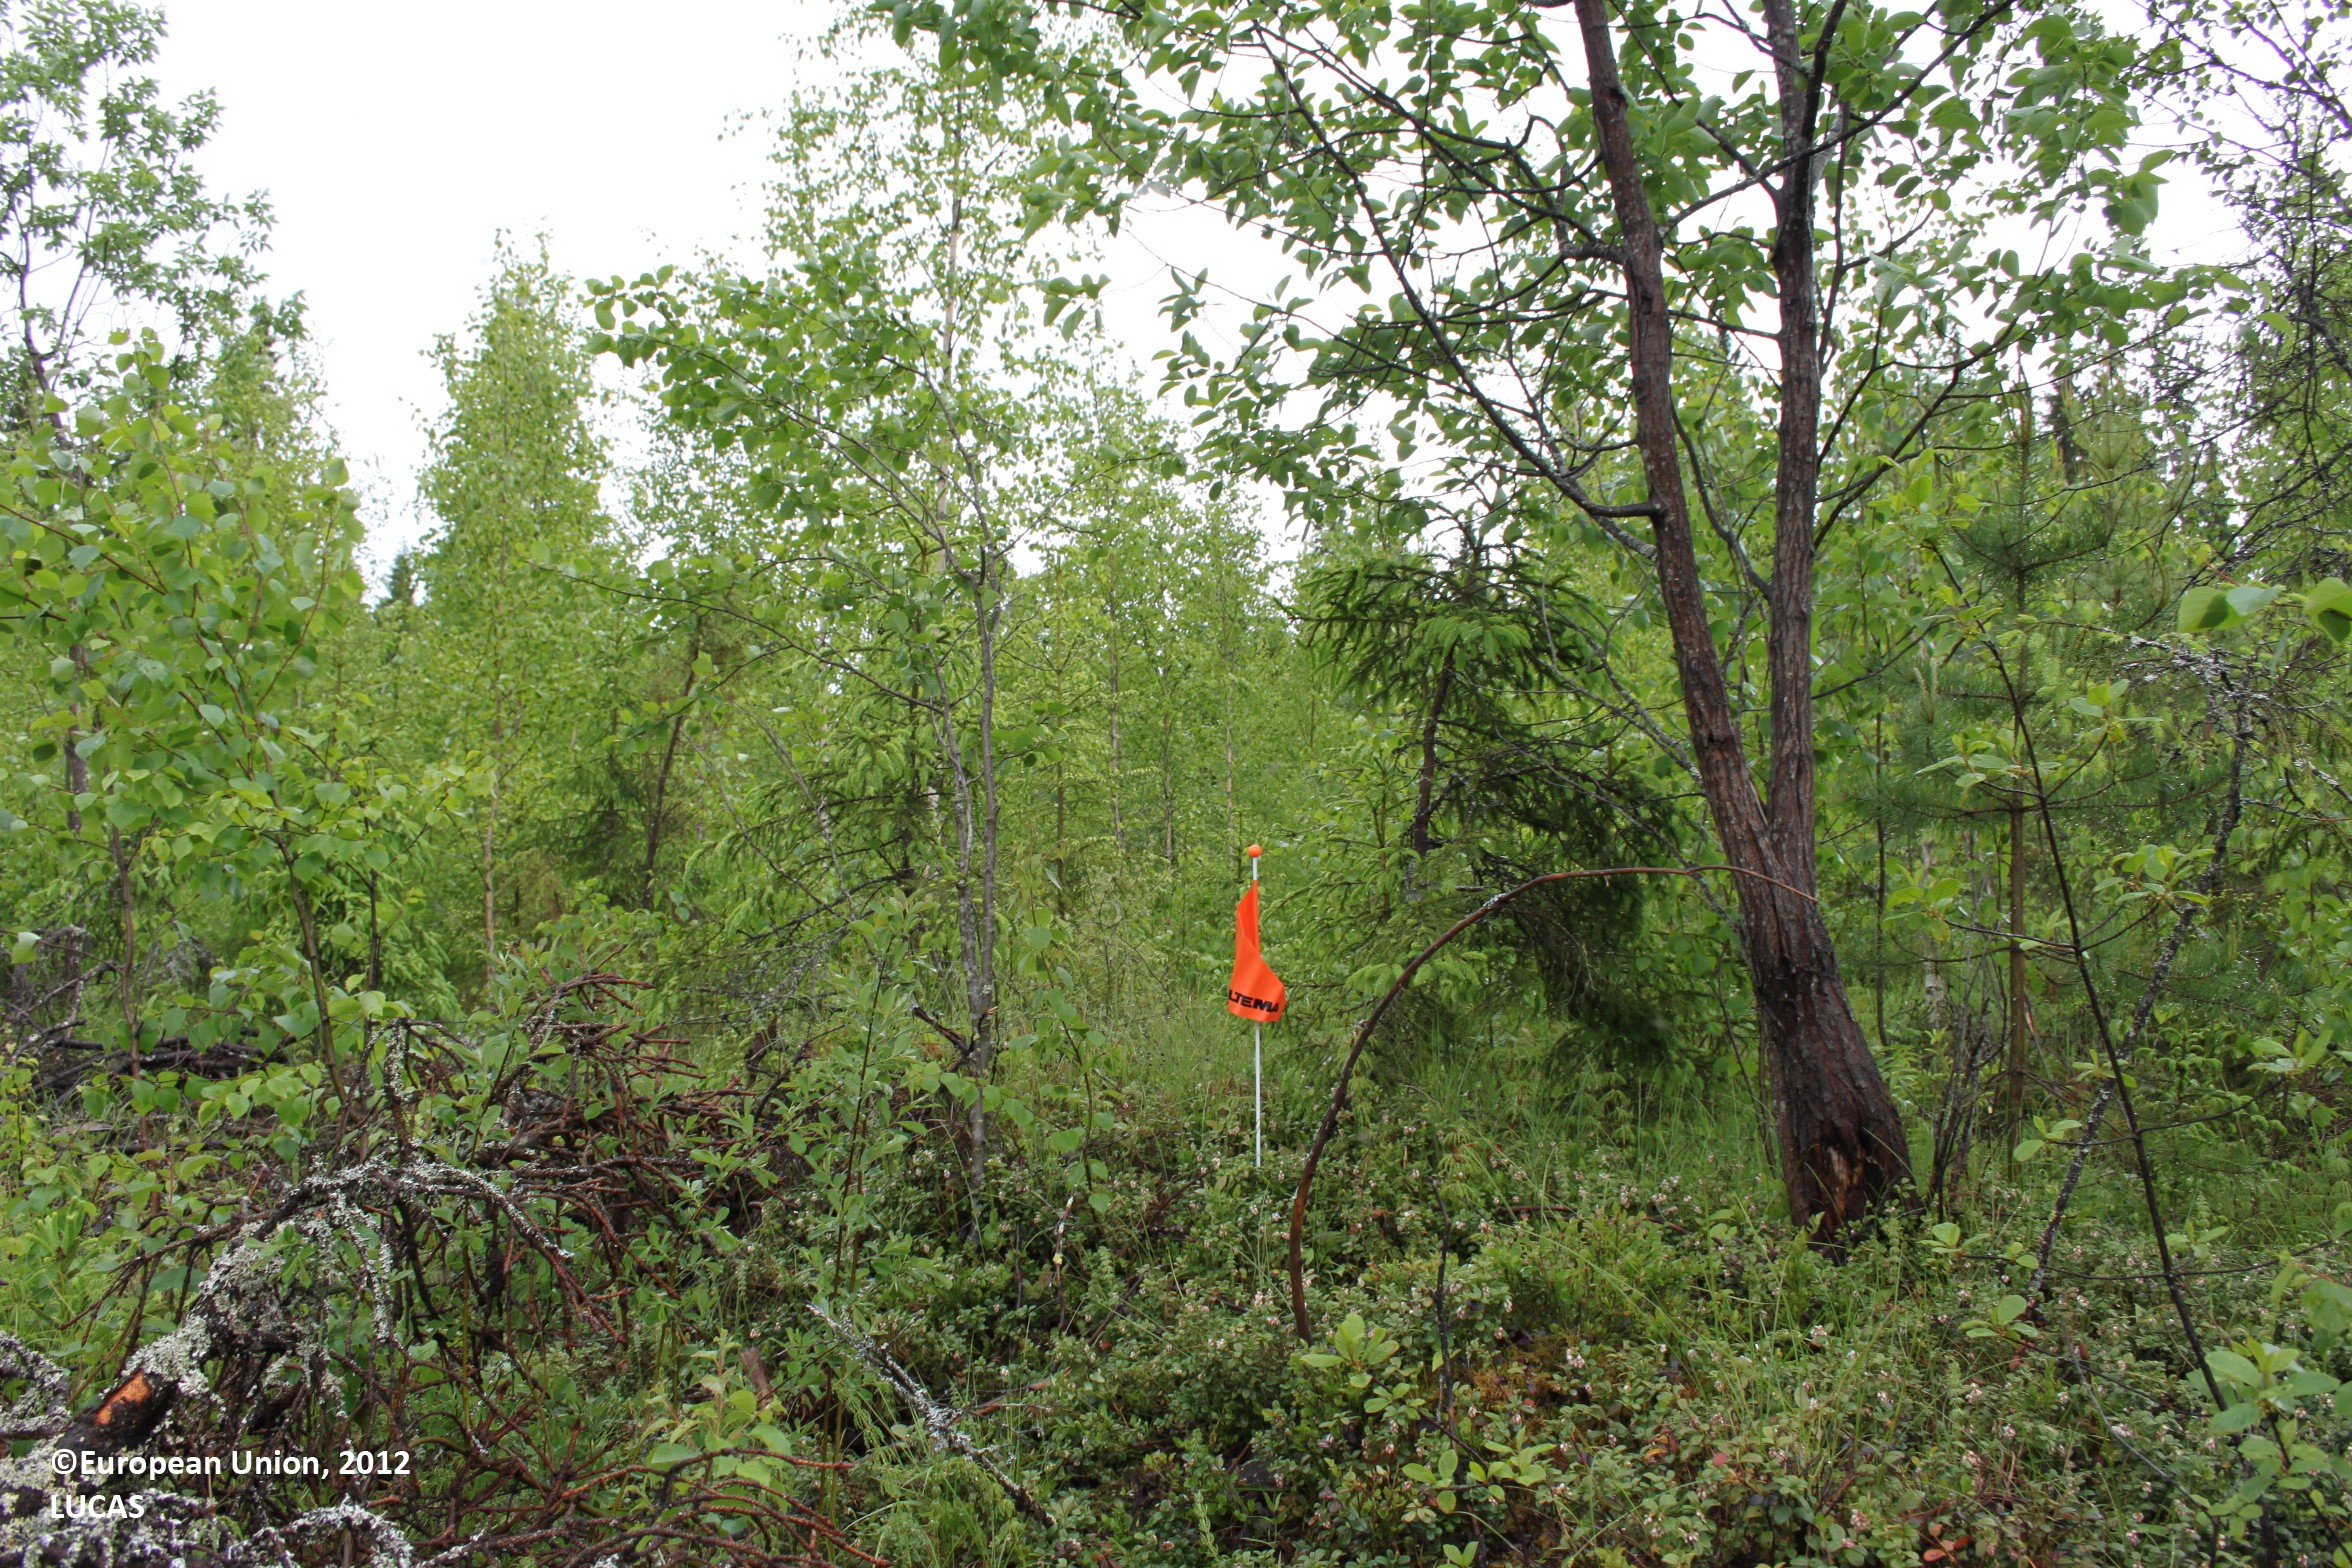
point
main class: Woodland
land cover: Broadleaved woodland
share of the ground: > 75 %
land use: Forestry
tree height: < 5 m
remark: Harvested field
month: June
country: FI
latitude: 61.8019
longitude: 28.3588
